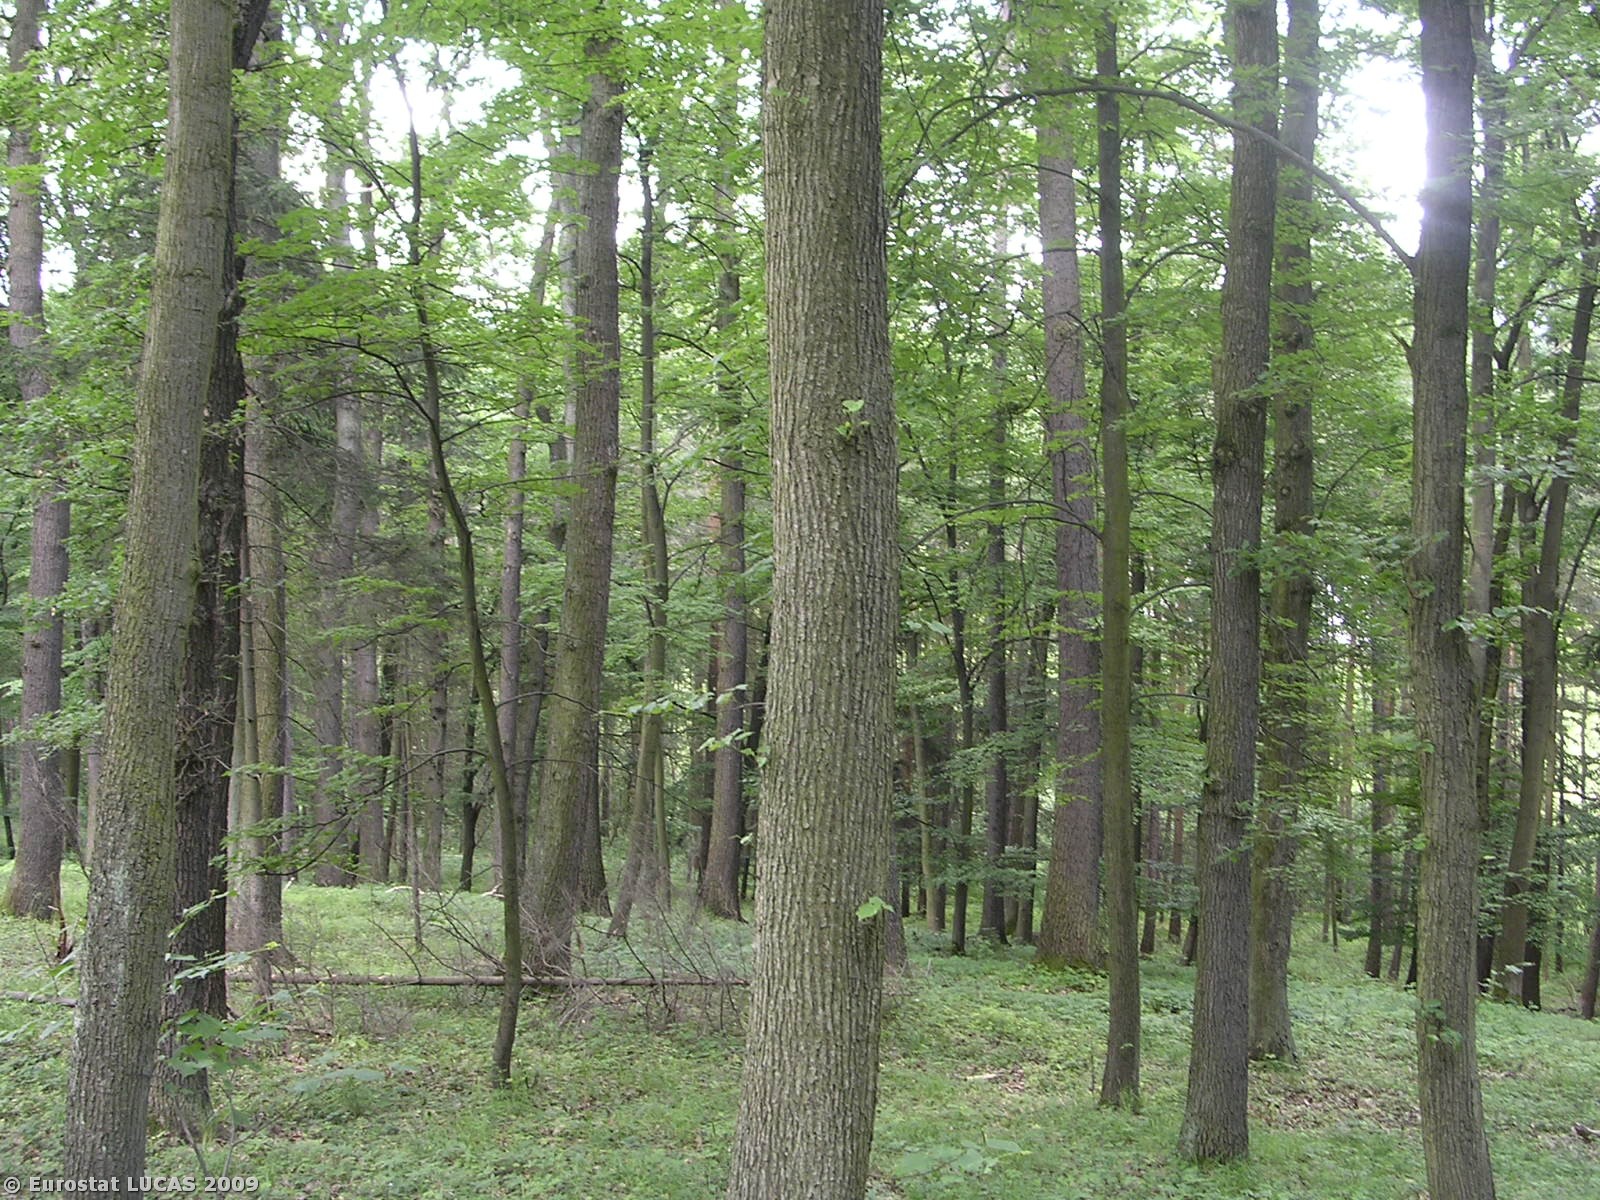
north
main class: Woodland
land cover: Broadleaved woodland
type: acidophilous oak and oak-birch forest
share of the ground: > 75 %
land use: Forestry
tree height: > 5 m
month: June
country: CZ
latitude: 50.5932
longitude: 14.1968
